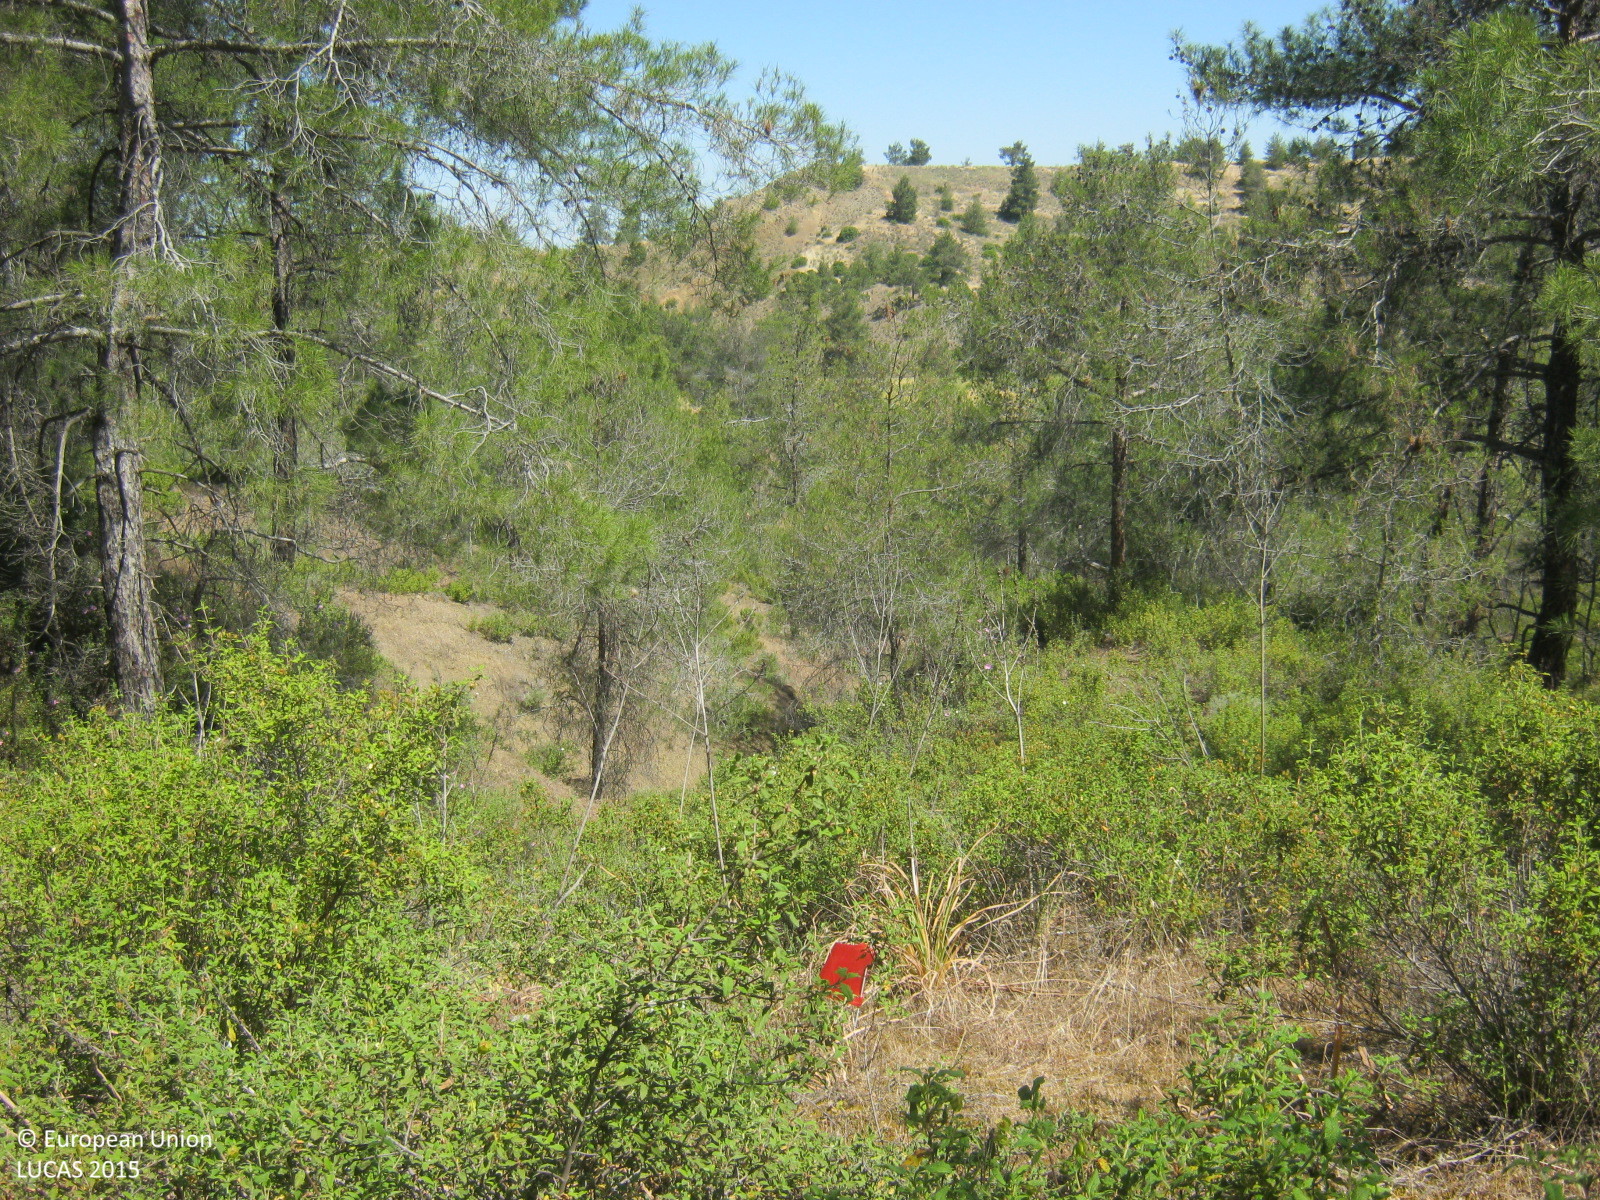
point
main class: Woodland
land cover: Pine dominated coniferous woodland
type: coniferous forest of the mediterranean region
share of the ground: > 75 %
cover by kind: coniferous forest trees 75 %, shrubs 10 %, herbaceous plants 10 %, unconsolidated bare surface 5 %
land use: Forestry
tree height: > 5 m
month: May
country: CY
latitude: 34.9989
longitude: 33.2245
